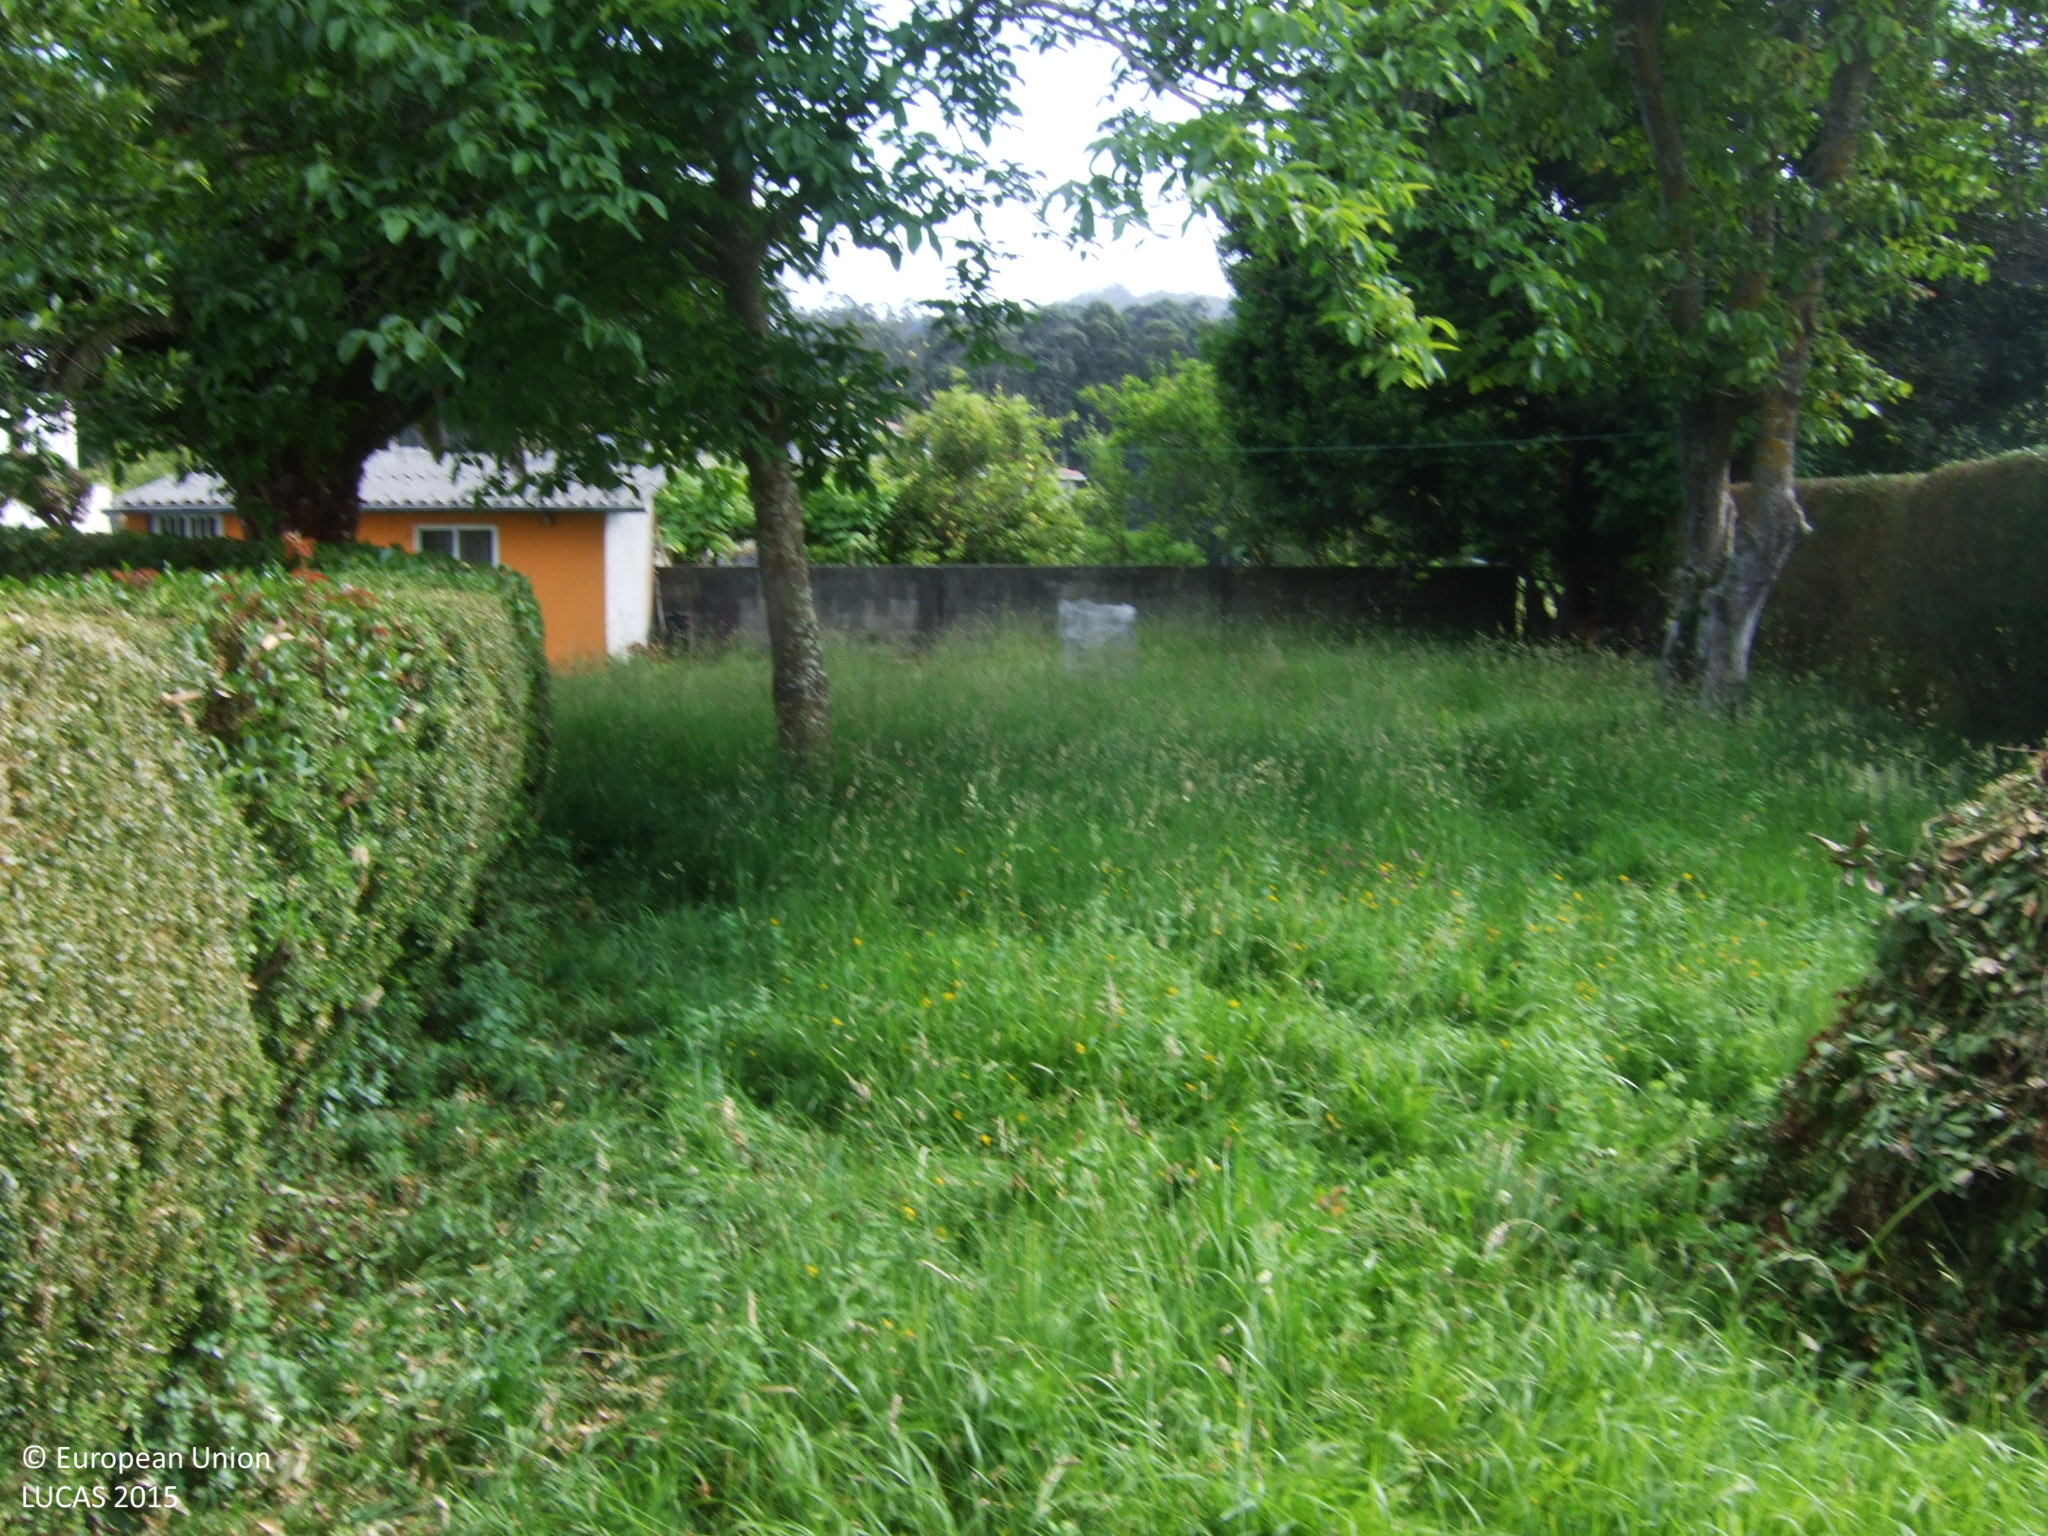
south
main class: Grassland
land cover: Grassland without tree/shrub cover
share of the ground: > 75 %
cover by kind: herbaceous plants 100 %
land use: Agriculture (excluding fallow land and kitchen gardens)
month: June
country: ES
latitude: 43.6945
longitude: -7.6189
